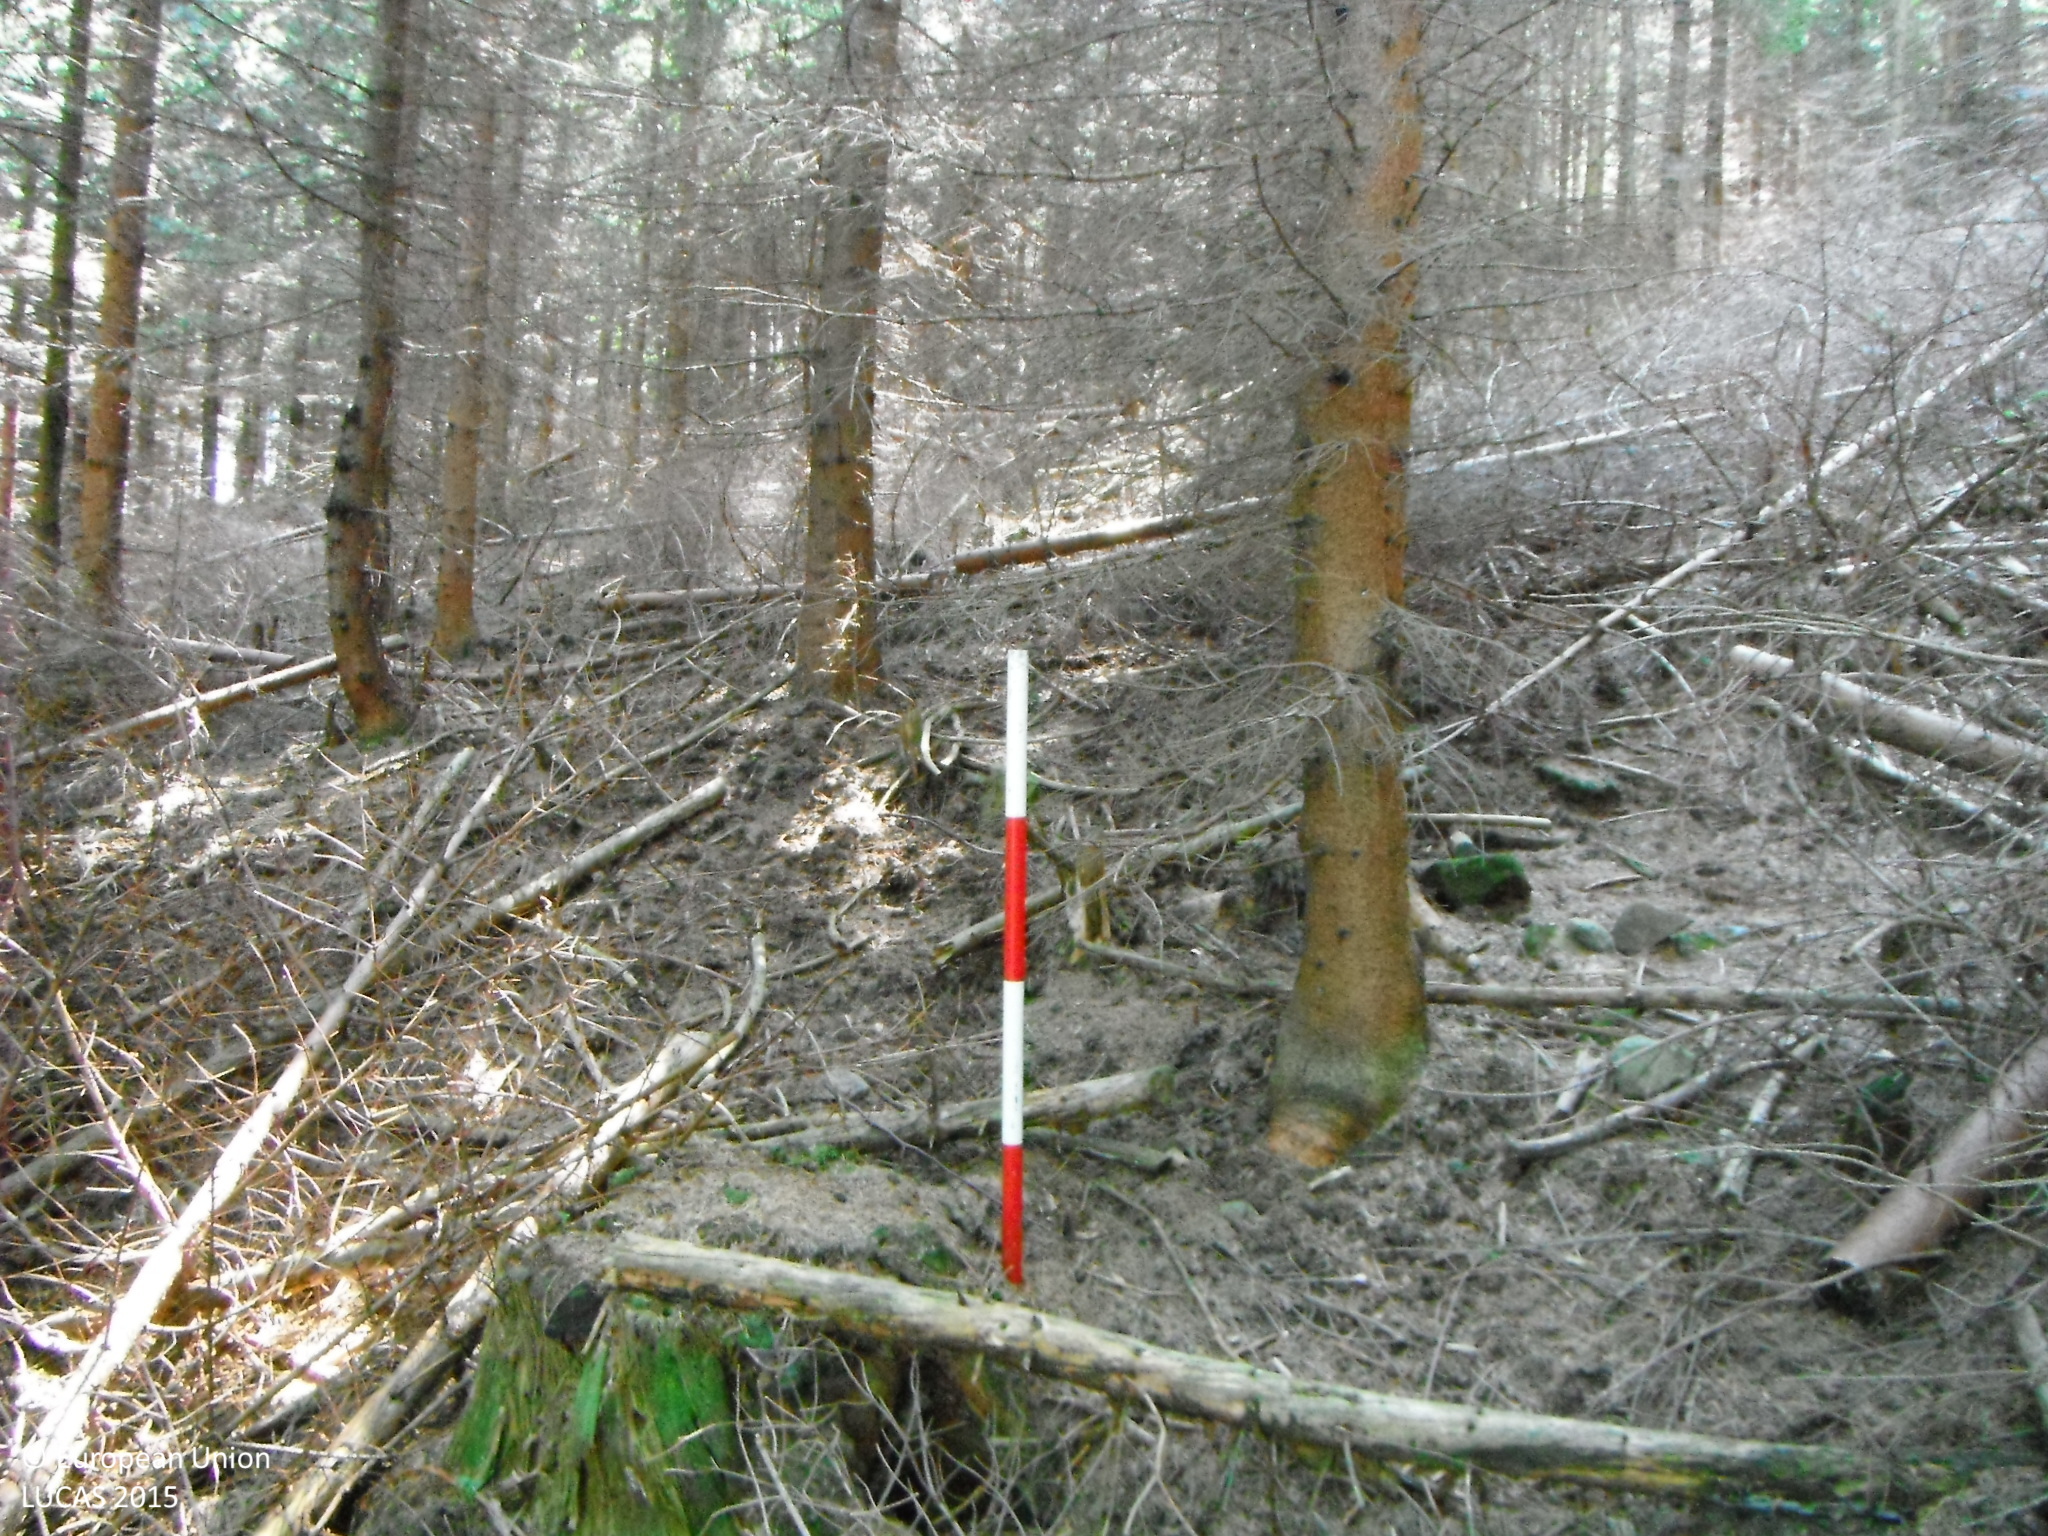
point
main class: Woodland
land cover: Spruce dominated coniferous woodland
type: alpine coniferous forest
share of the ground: > 75 %
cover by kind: coniferous forest trees 100 %
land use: Forestry
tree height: > 5 m
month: August
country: SK
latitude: 49.3893
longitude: 18.8242
